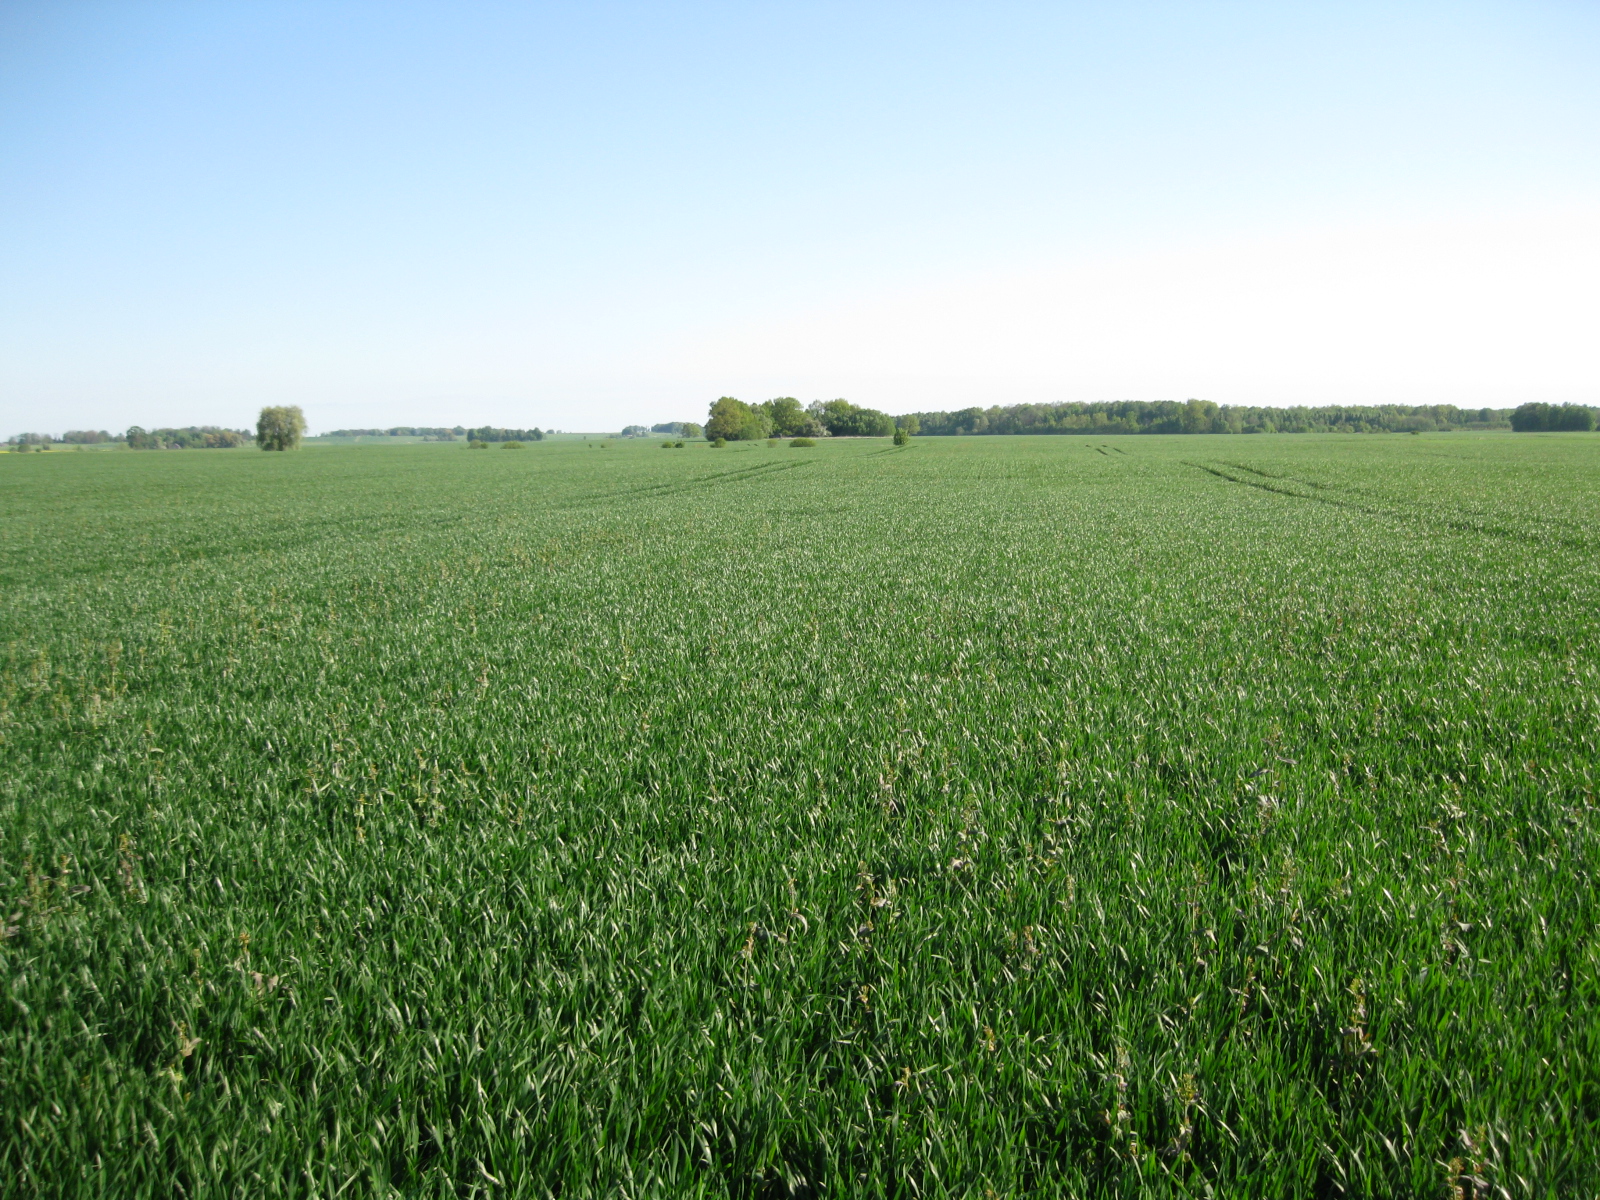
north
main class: Cropland
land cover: Common wheat
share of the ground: > 75 %
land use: Agriculture (excluding fallow land and kitchen gardens)
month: May
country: LT
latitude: 56.0750
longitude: 24.1478
